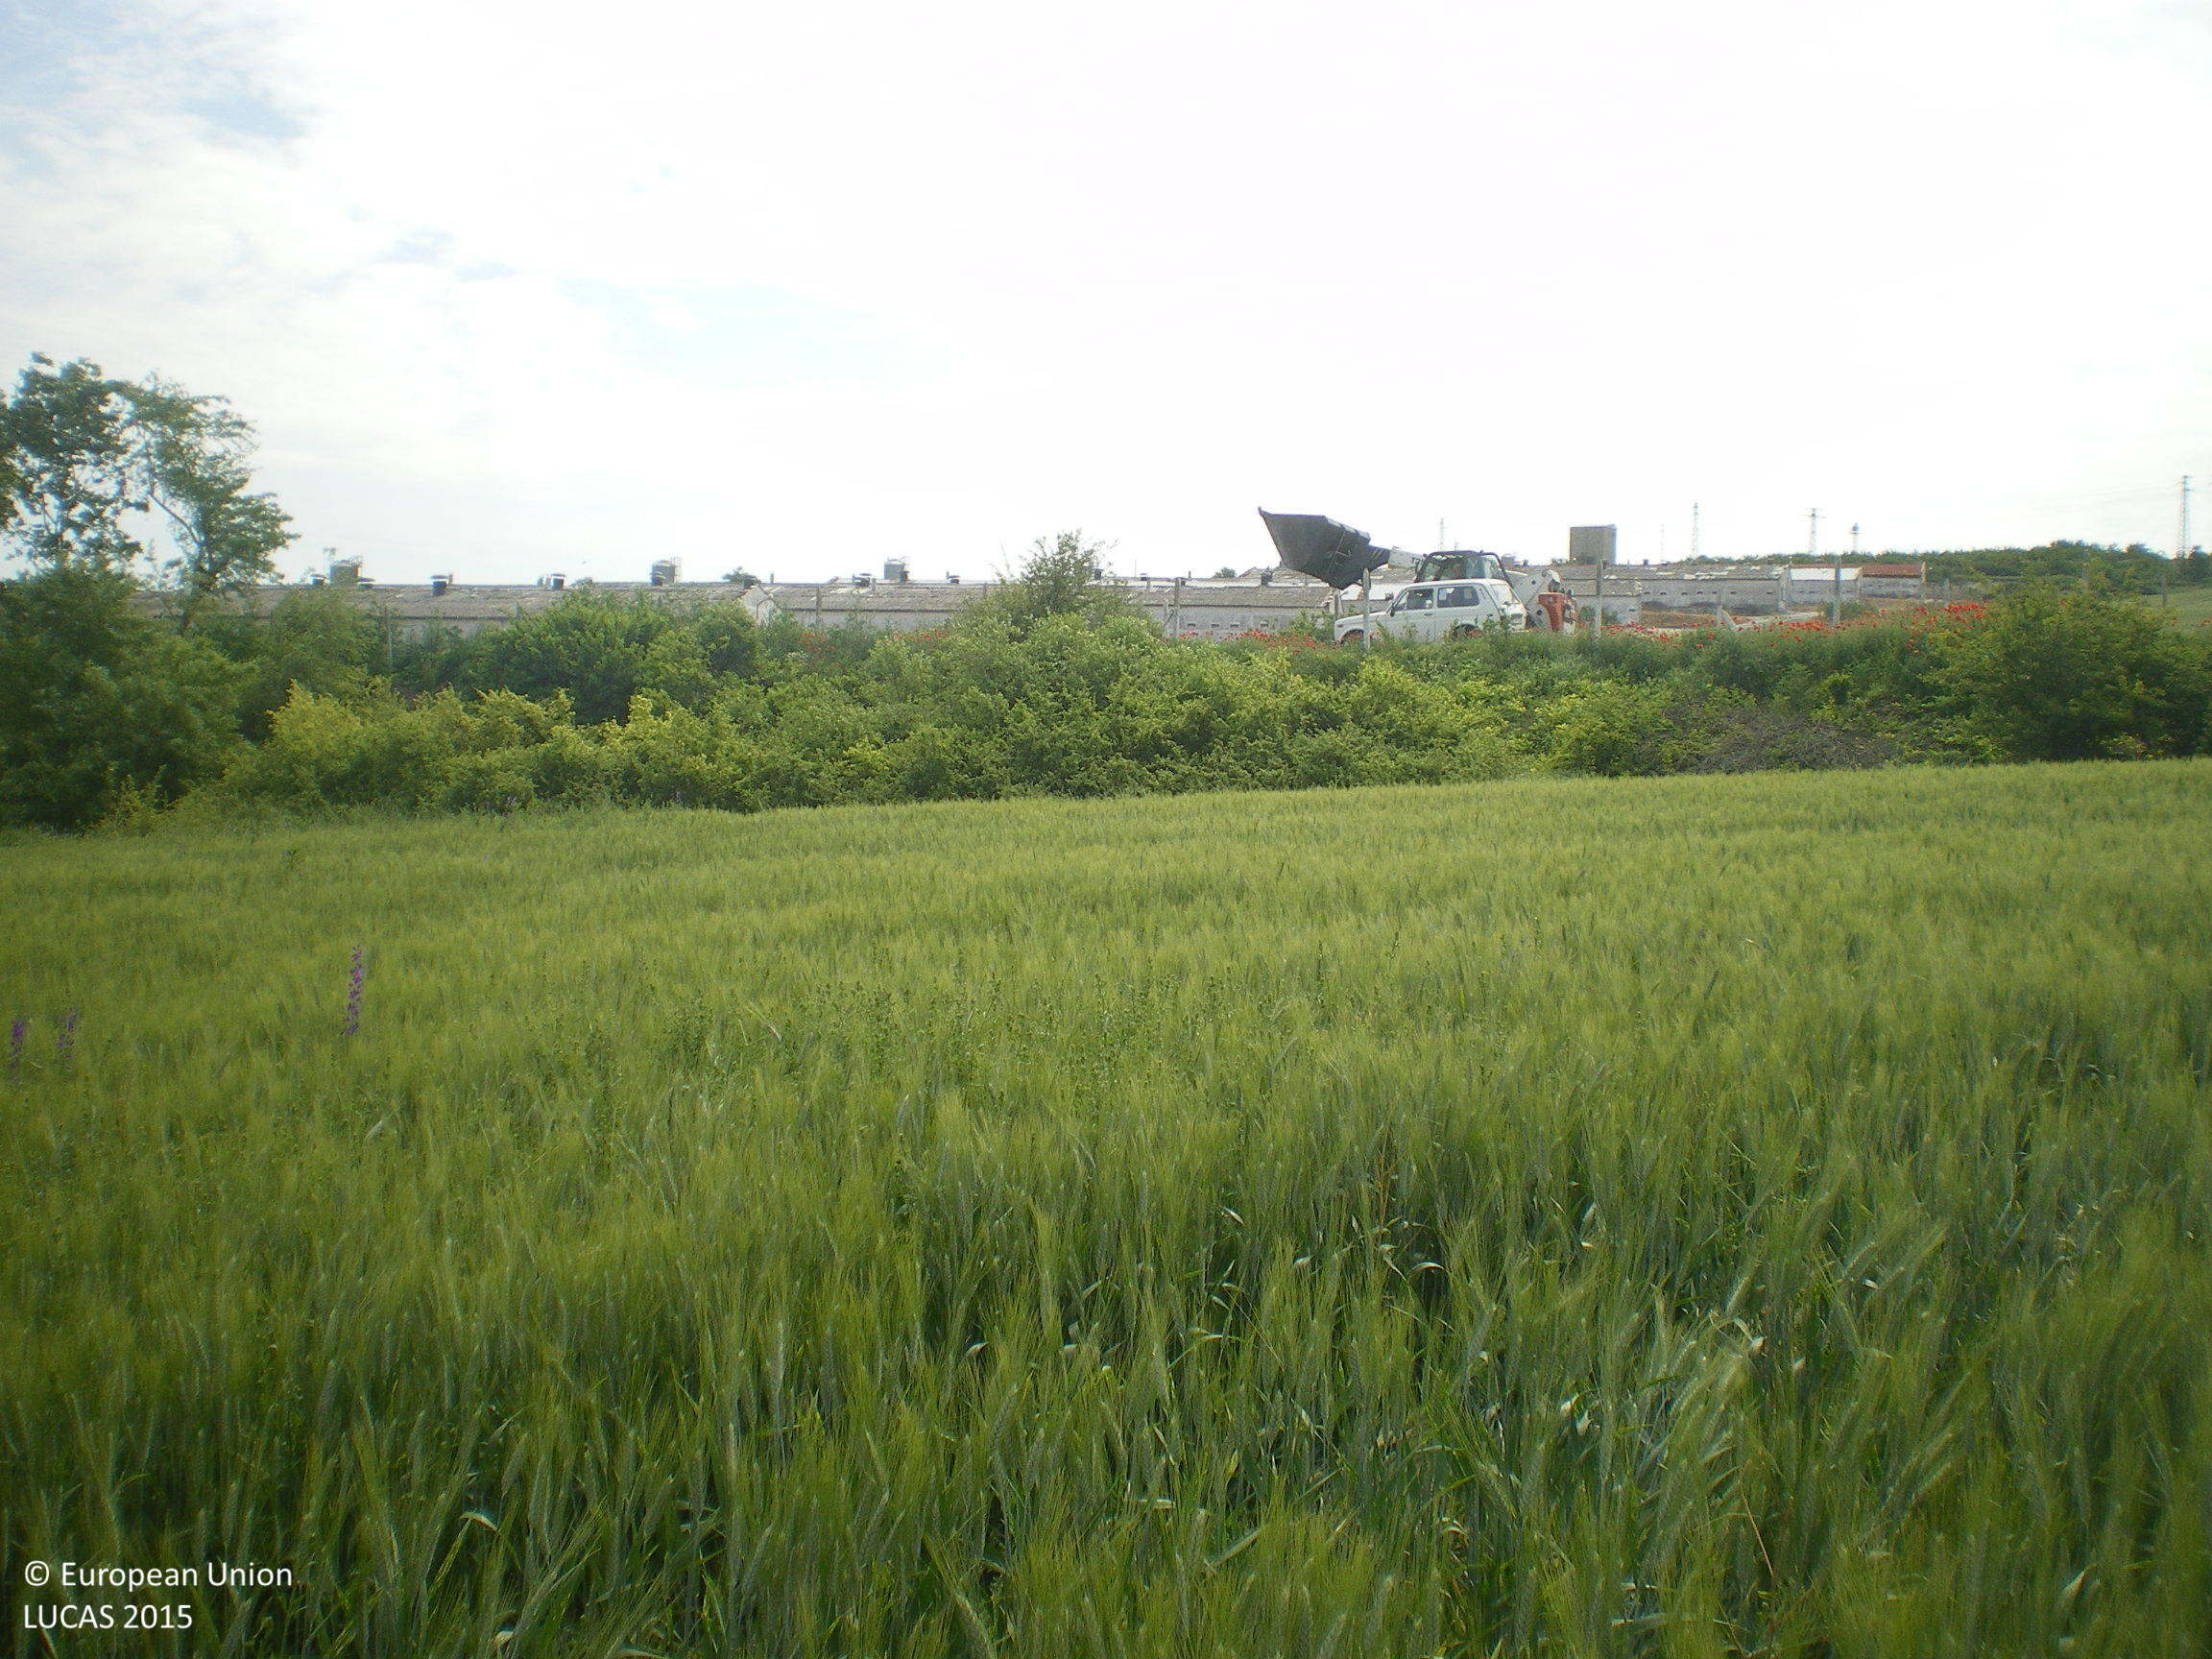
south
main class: Cropland
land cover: Barley
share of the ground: > 75 %
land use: Agriculture (excluding fallow land and kitchen gardens)
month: May
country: BG
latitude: 42.2257
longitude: 25.3662
